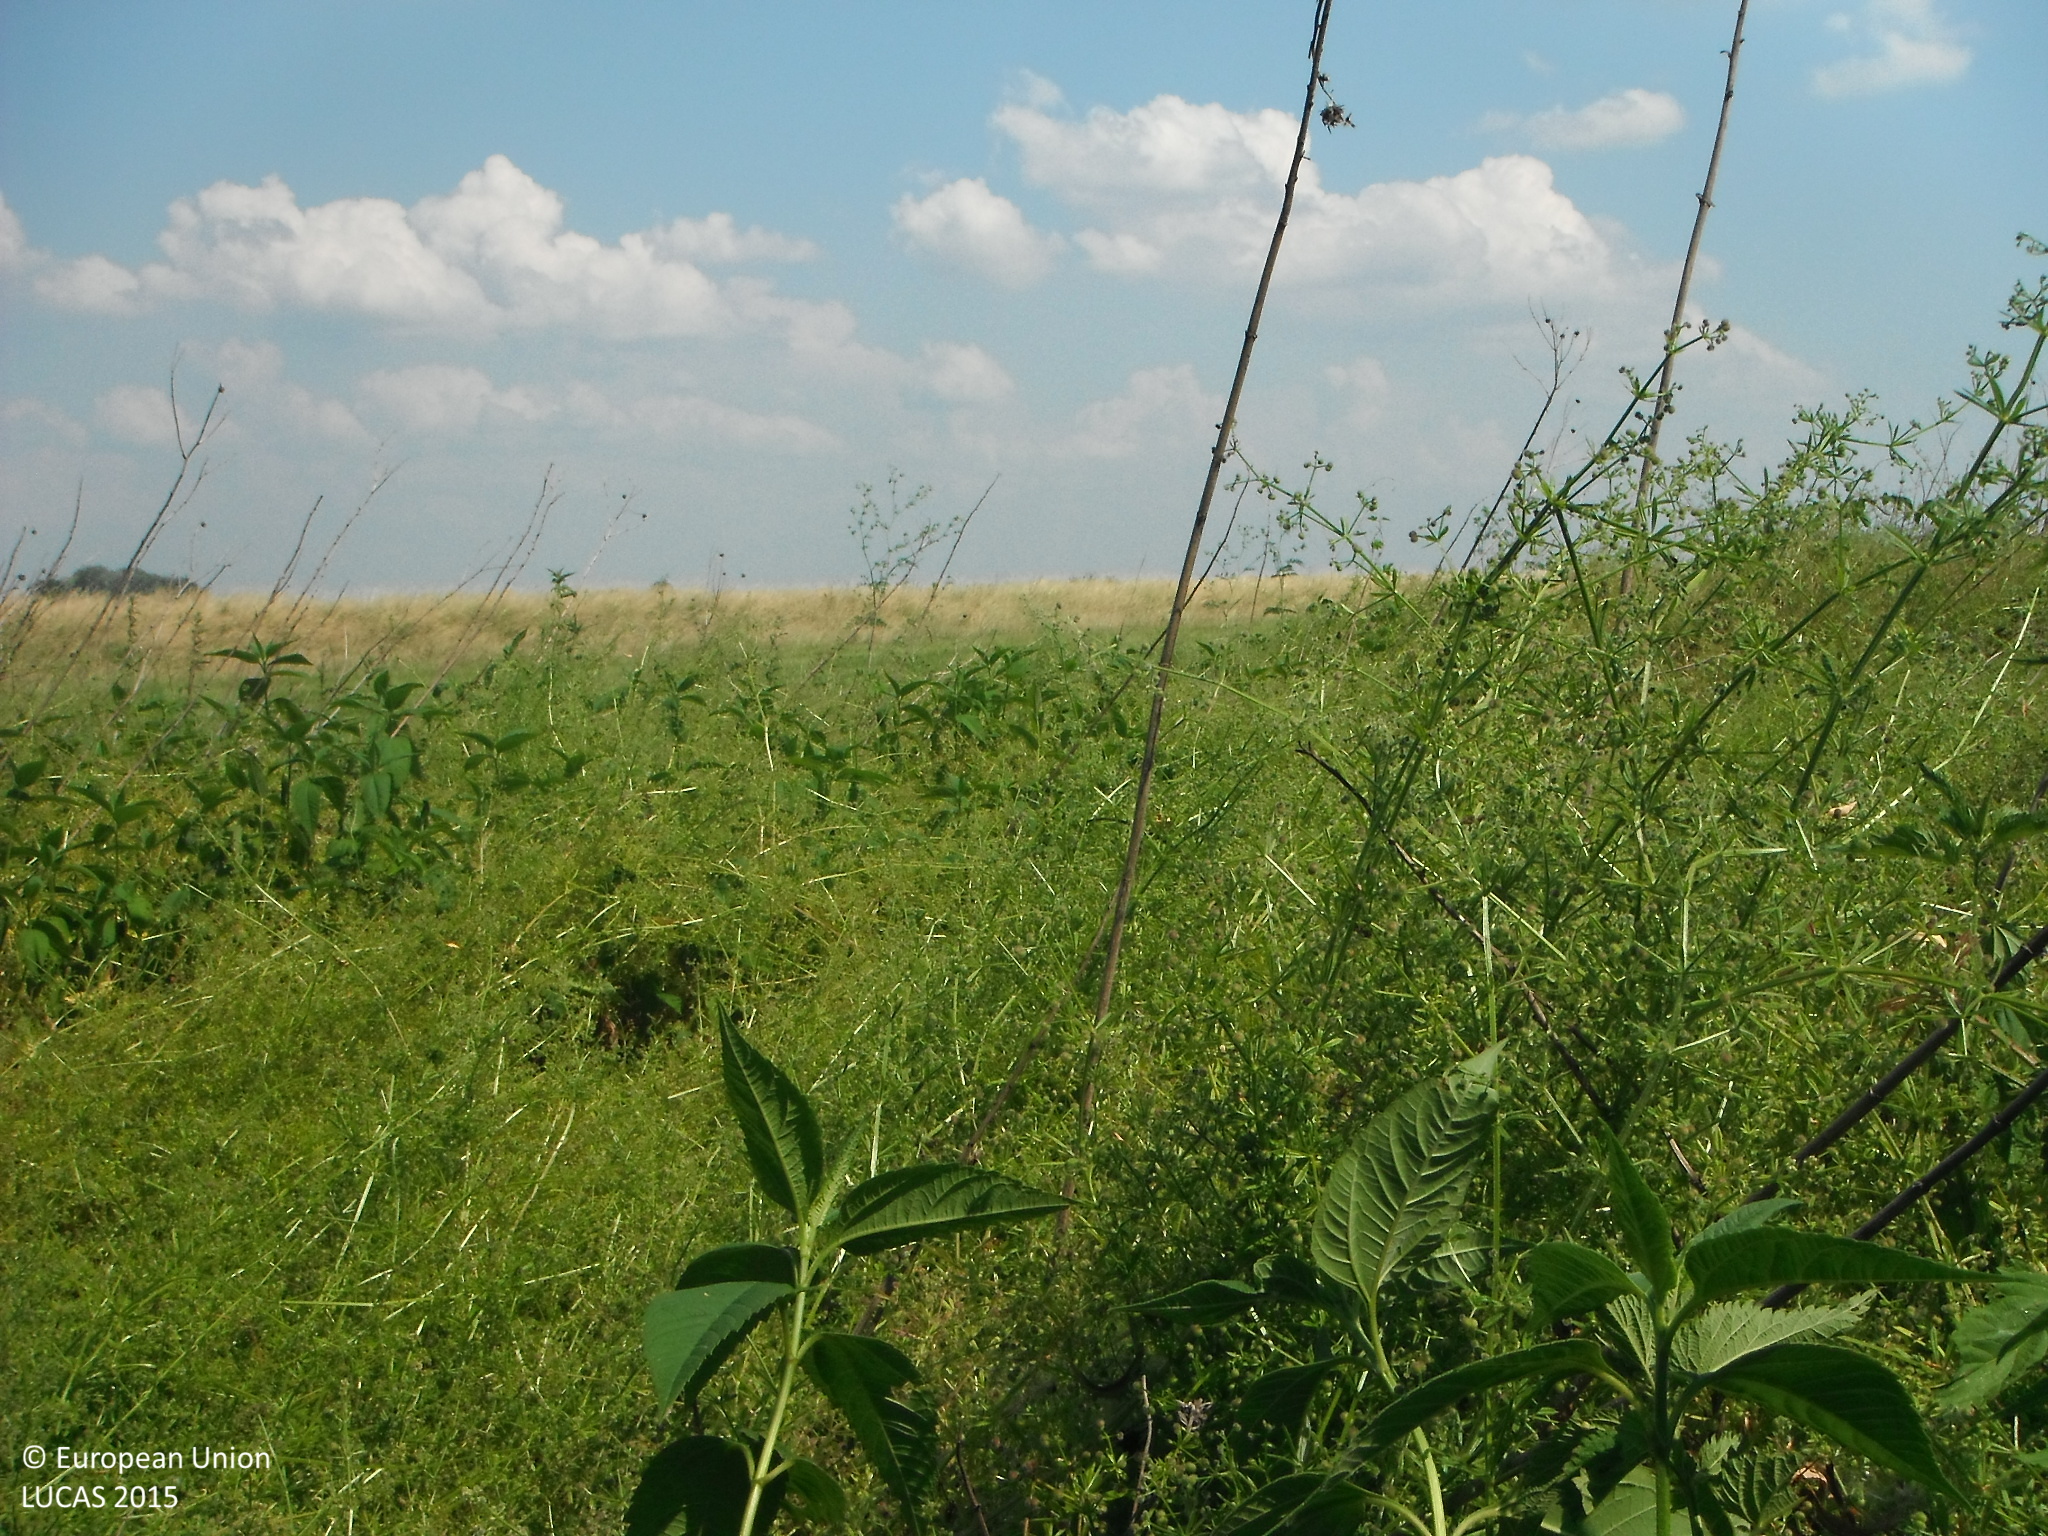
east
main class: Woodland
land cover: Broadleaved woodland
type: mesophytic deciduous forest
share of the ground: > 75 %
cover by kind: broadleaved forest trees 100 %
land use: Semi-natural and natural areas not in use
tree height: > 5 m
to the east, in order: Broadleaved woodland; Spontaneously vegetated surfaces; Barley; Spontaneously vegetated surfaces; Tracks; Grassland without tree/shrub cover; Soya
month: June
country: SK
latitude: 48.6256
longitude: 22.1175
